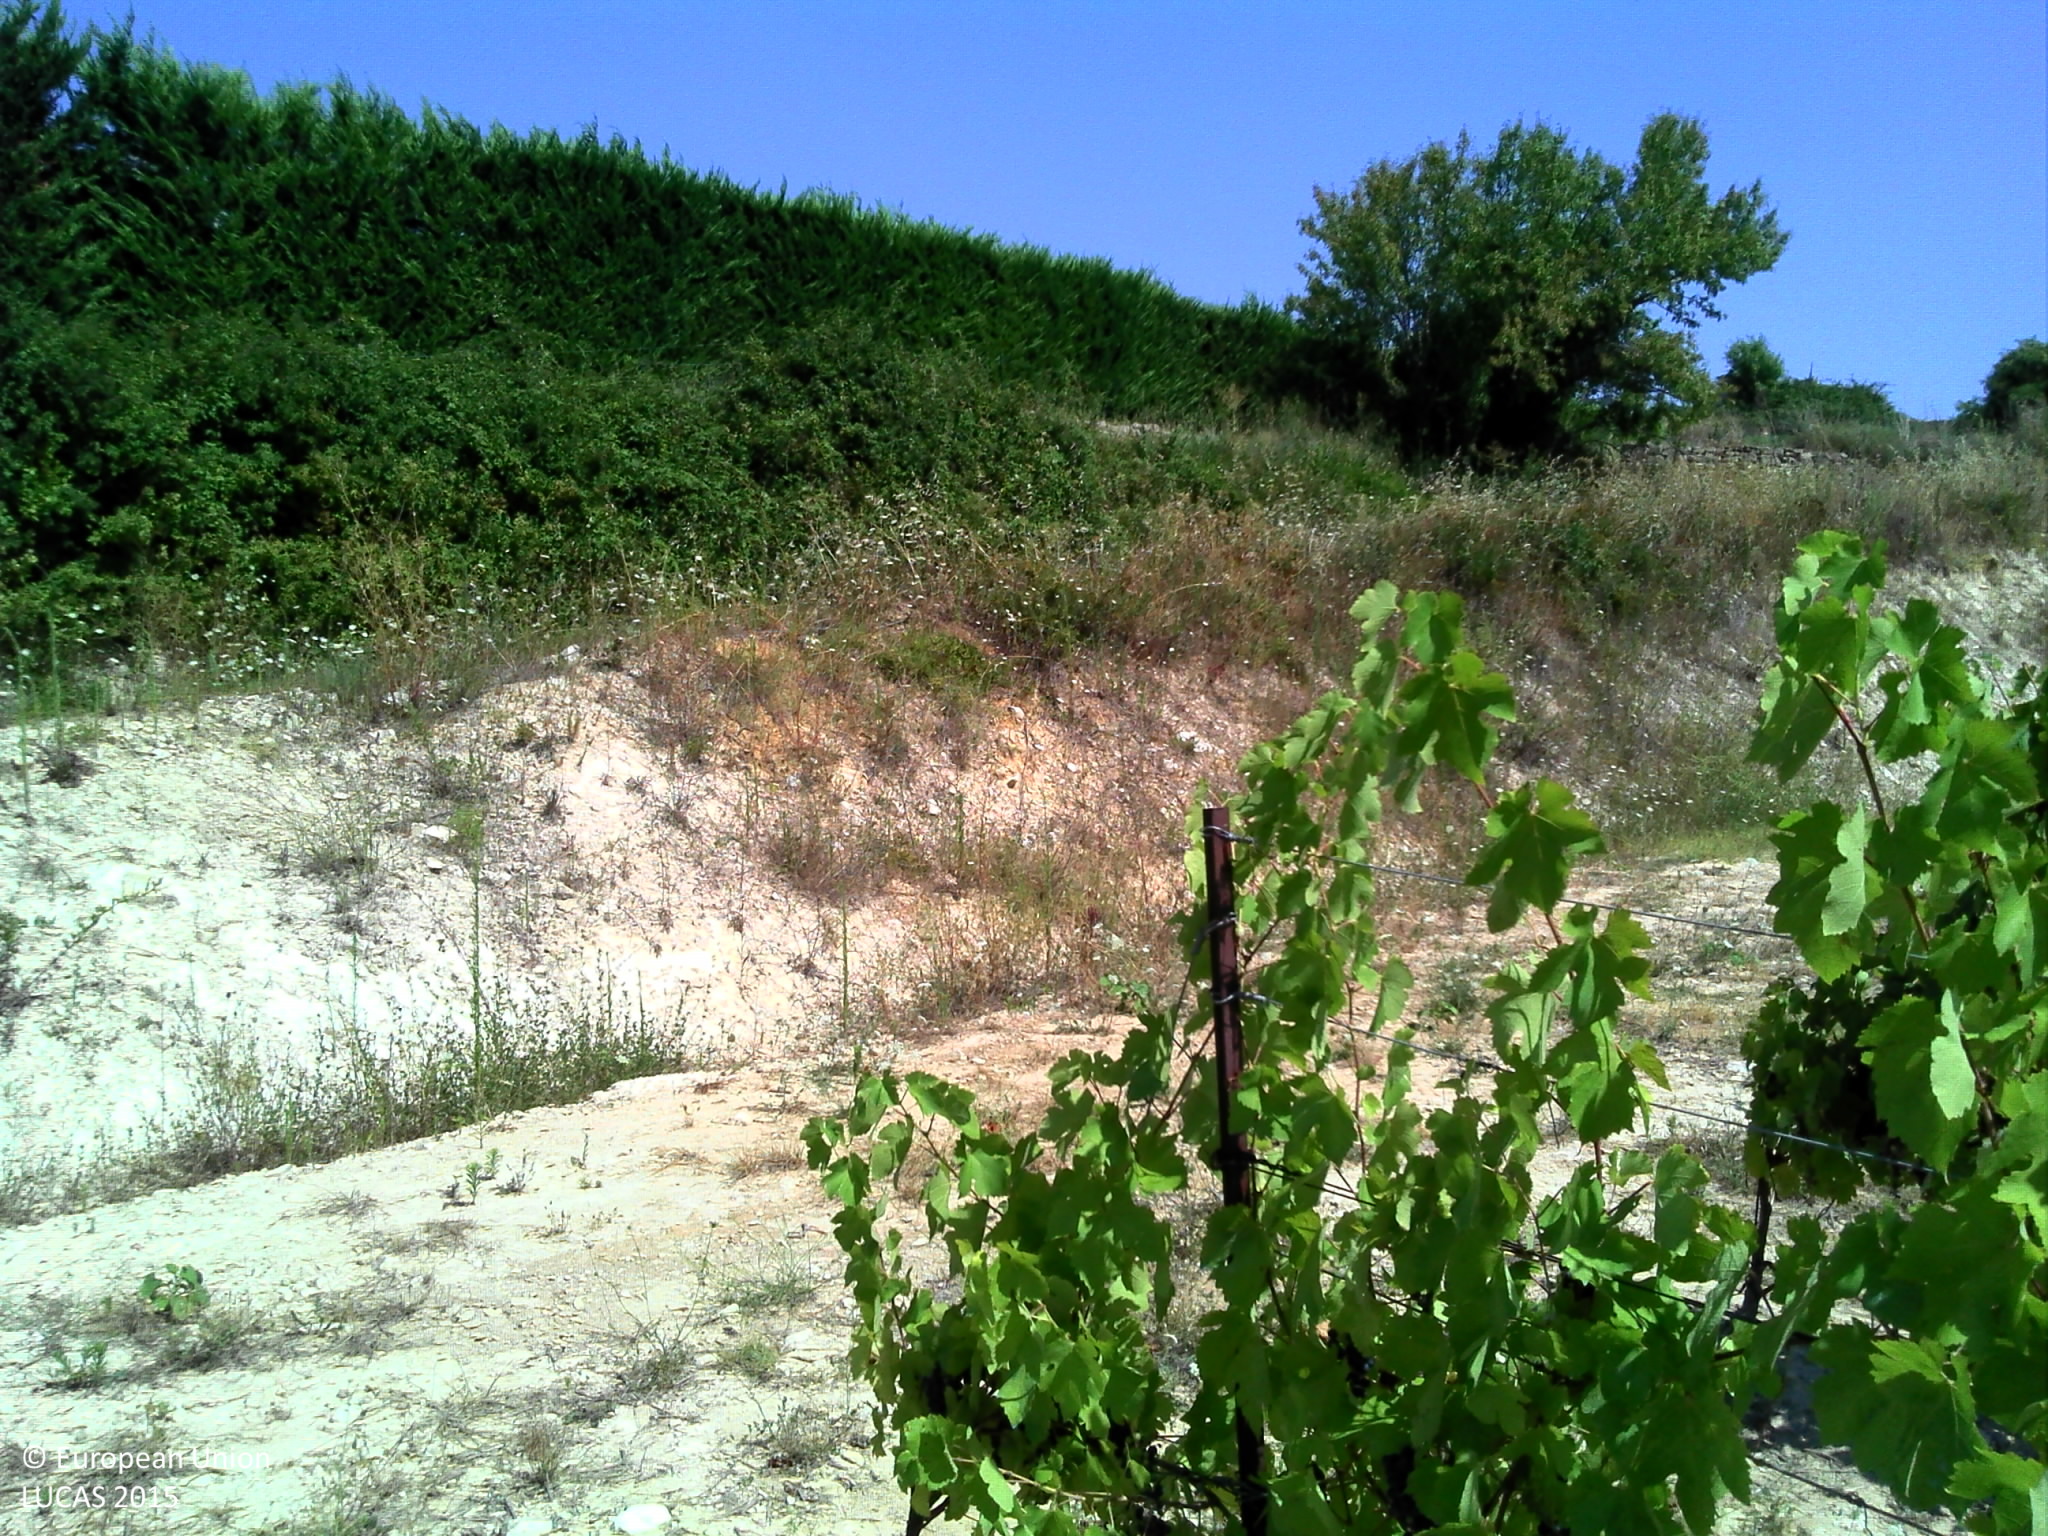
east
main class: Cropland
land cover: Vineyards
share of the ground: 25 - 50 %
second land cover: Other bare soil
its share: > 75 %
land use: Agriculture (excluding fallow land and kitchen gardens)
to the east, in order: Vineyards; Other bare soil; Managed hedges; Tracks; Managed hedges; Dry stone walls; Fences; Conifer hedges; Olive groves; Artificial constructions in urban areas; Lines of trees; Fences; Tracks; Dry stone walls; Vineyards; Tracks; Grass margins; Dry stone walls; Shrubland without tree cover
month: August
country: FR
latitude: 43.8284
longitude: 5.2960
